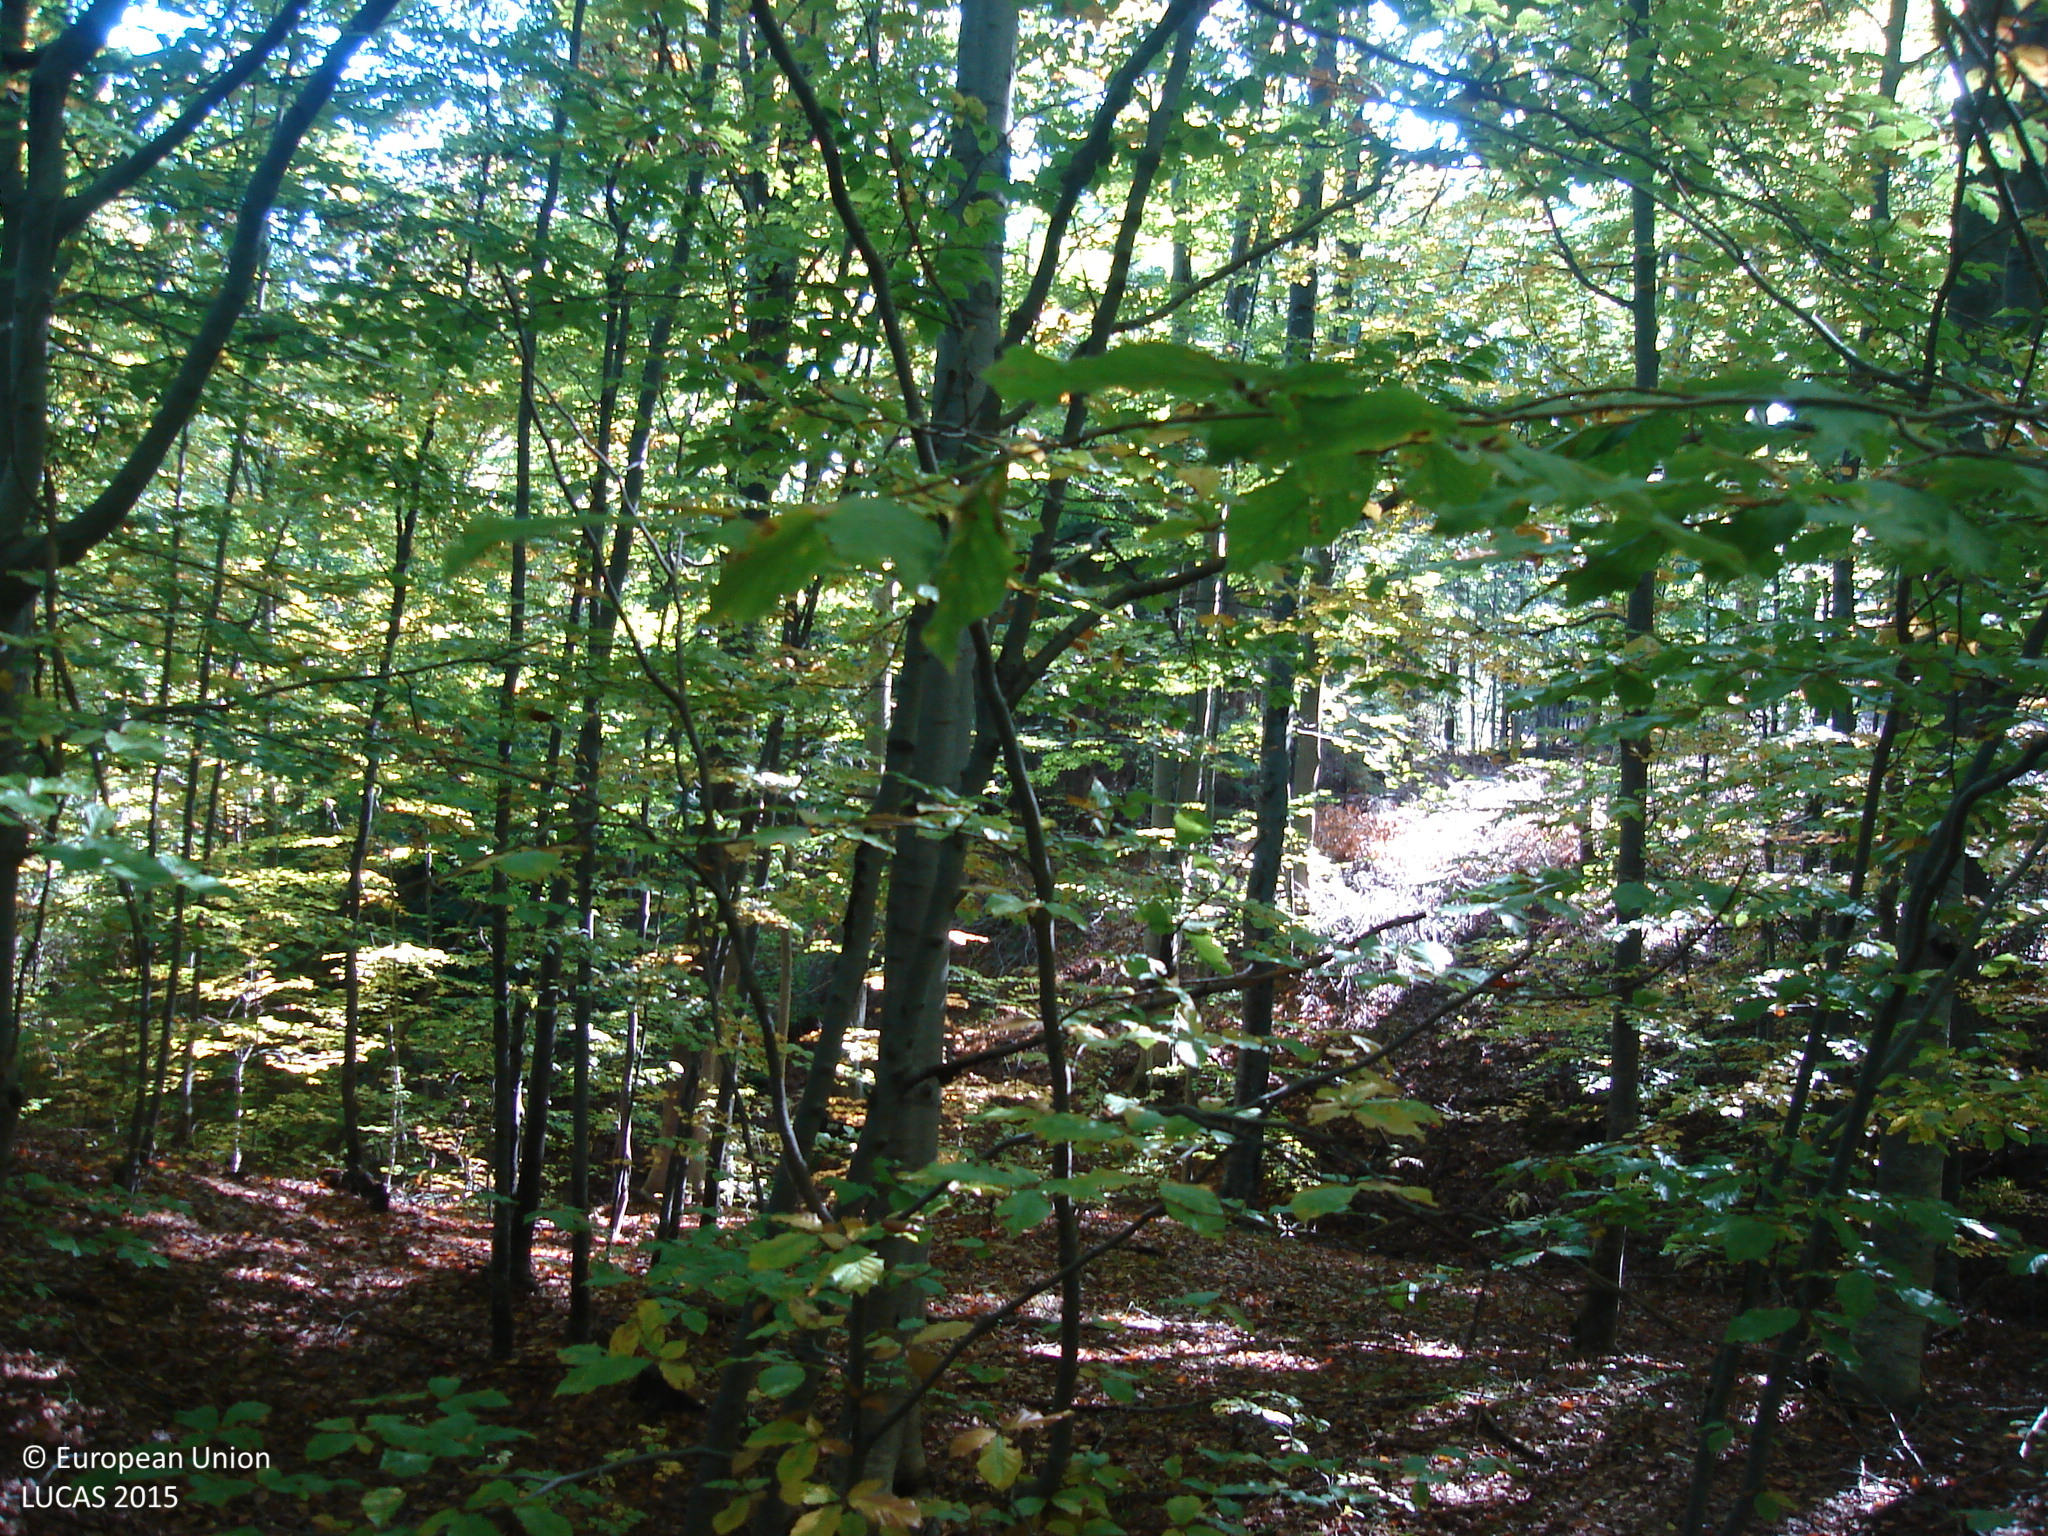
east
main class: Woodland
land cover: Broadleaved woodland
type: mountainous beech forest
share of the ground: > 75 %
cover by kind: broadleaved forest trees 80 %, unconsolidated bare surface 20 %
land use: Forestry
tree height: > 5 m
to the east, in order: Broadleaved woodland; Rivers and streams; Pine dominated coniferous woodland; Tracks; Pine dominated coniferous woodland; Grassland without tree/shrub cover
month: October
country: BG
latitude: 42.6144
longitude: 24.2254
